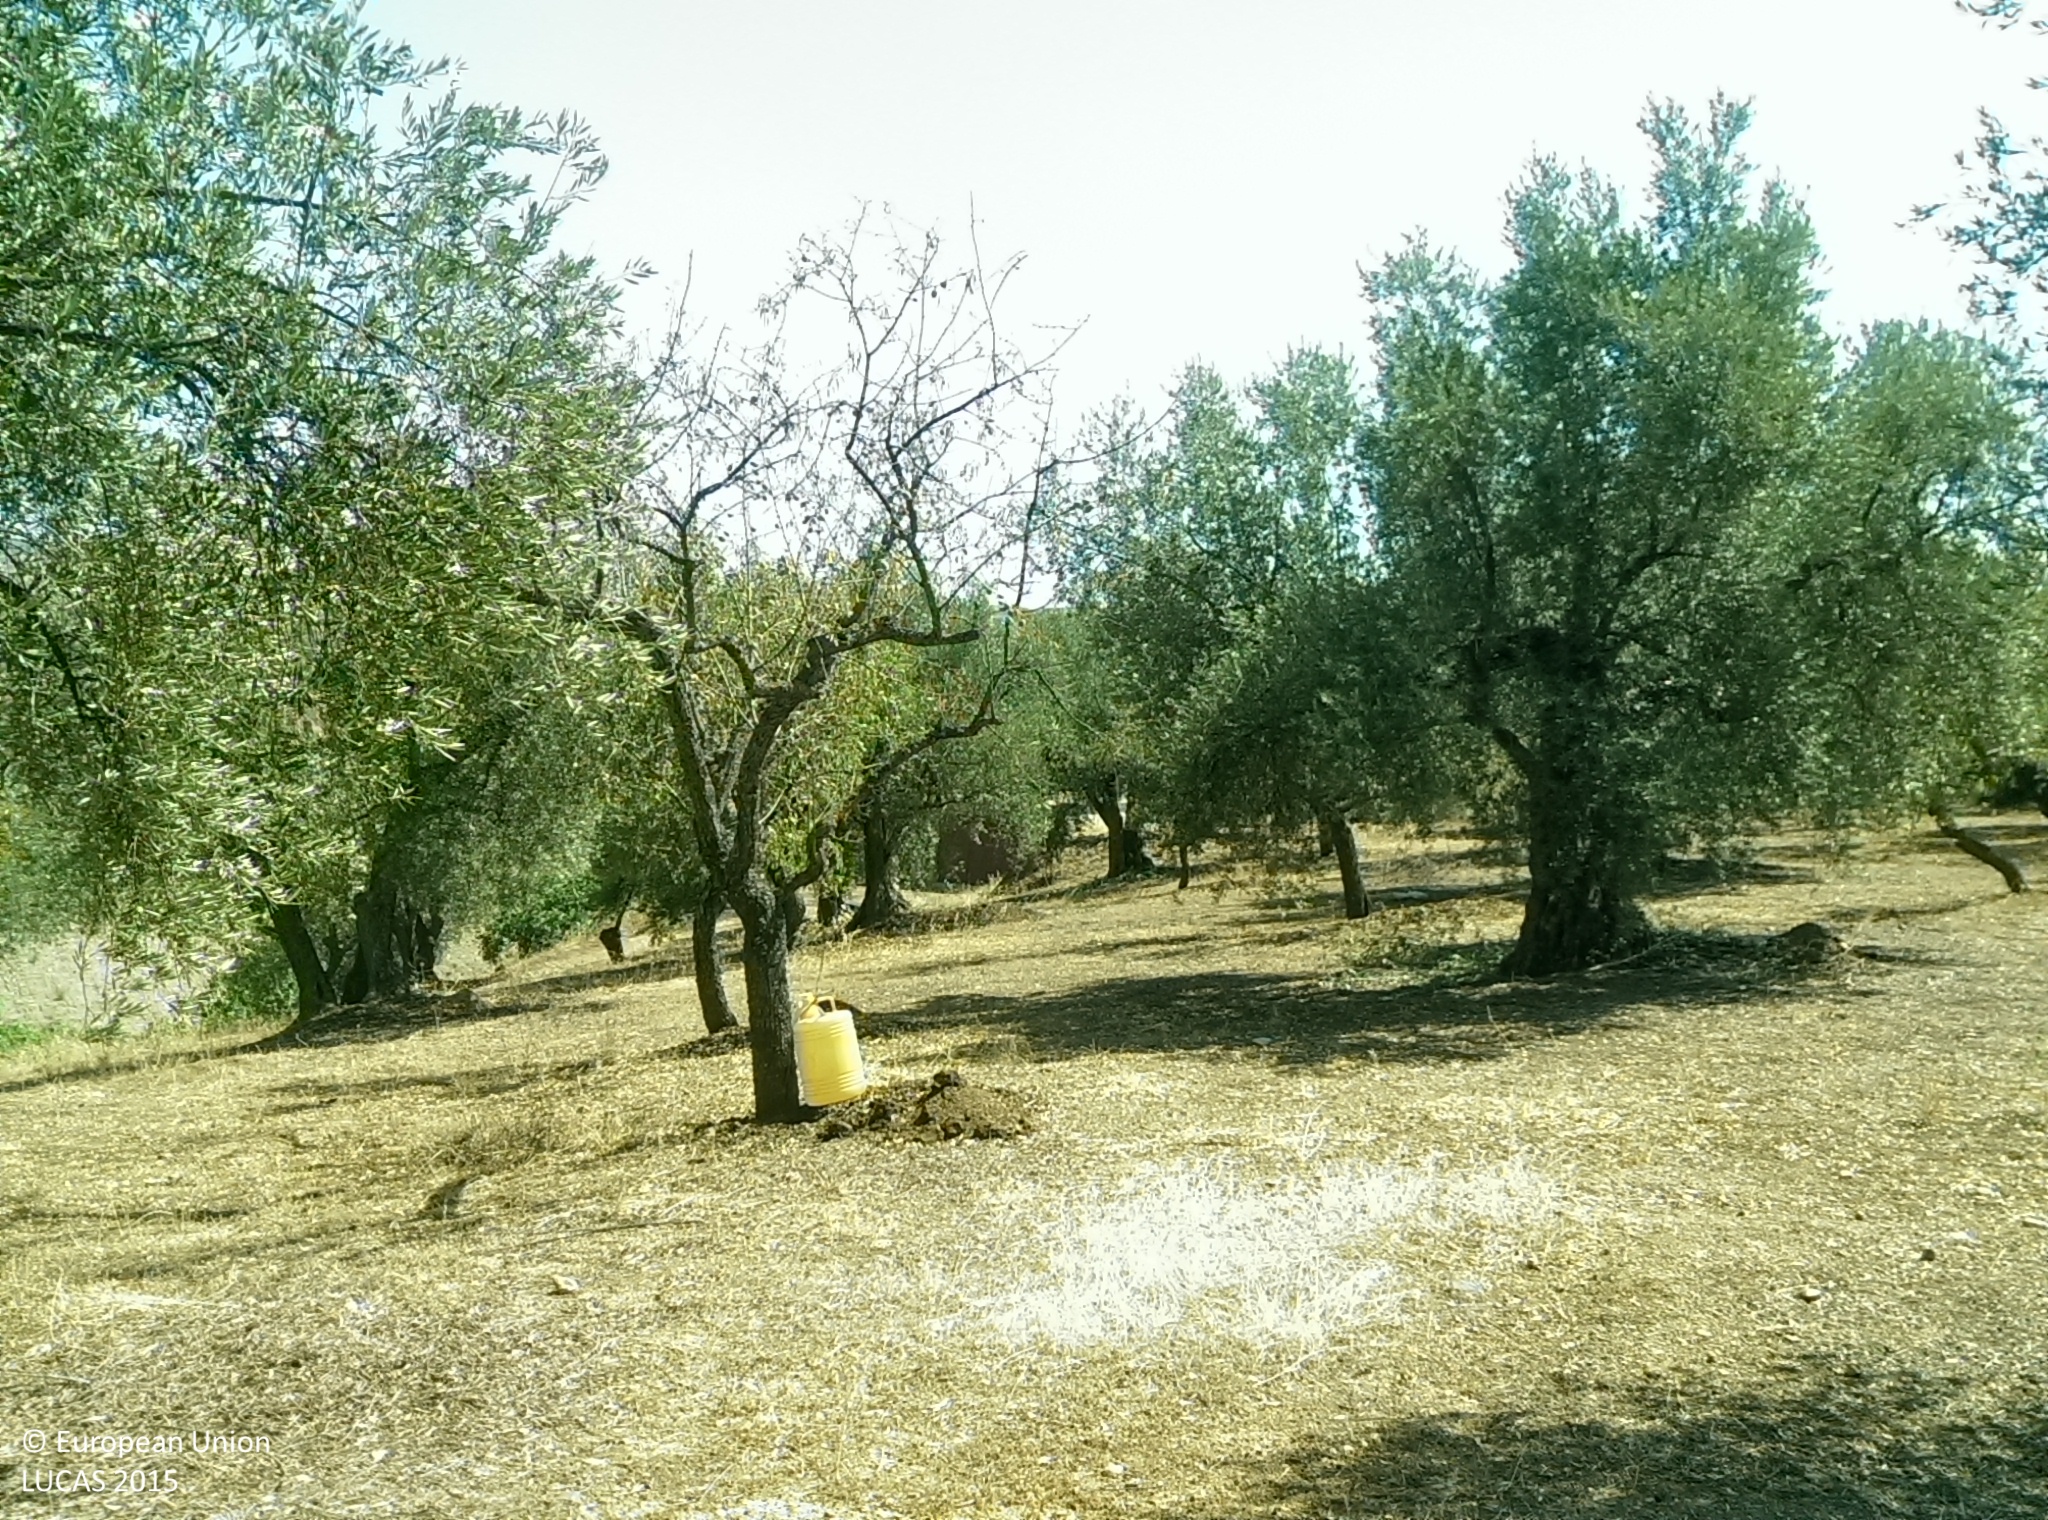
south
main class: Cropland
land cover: Olive groves
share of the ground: 10 - 25 %
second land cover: Nuts trees
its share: 10 - 25 %
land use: Agriculture (excluding fallow land and kitchen gardens)
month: July
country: ES
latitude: 36.9368
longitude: -3.1742
